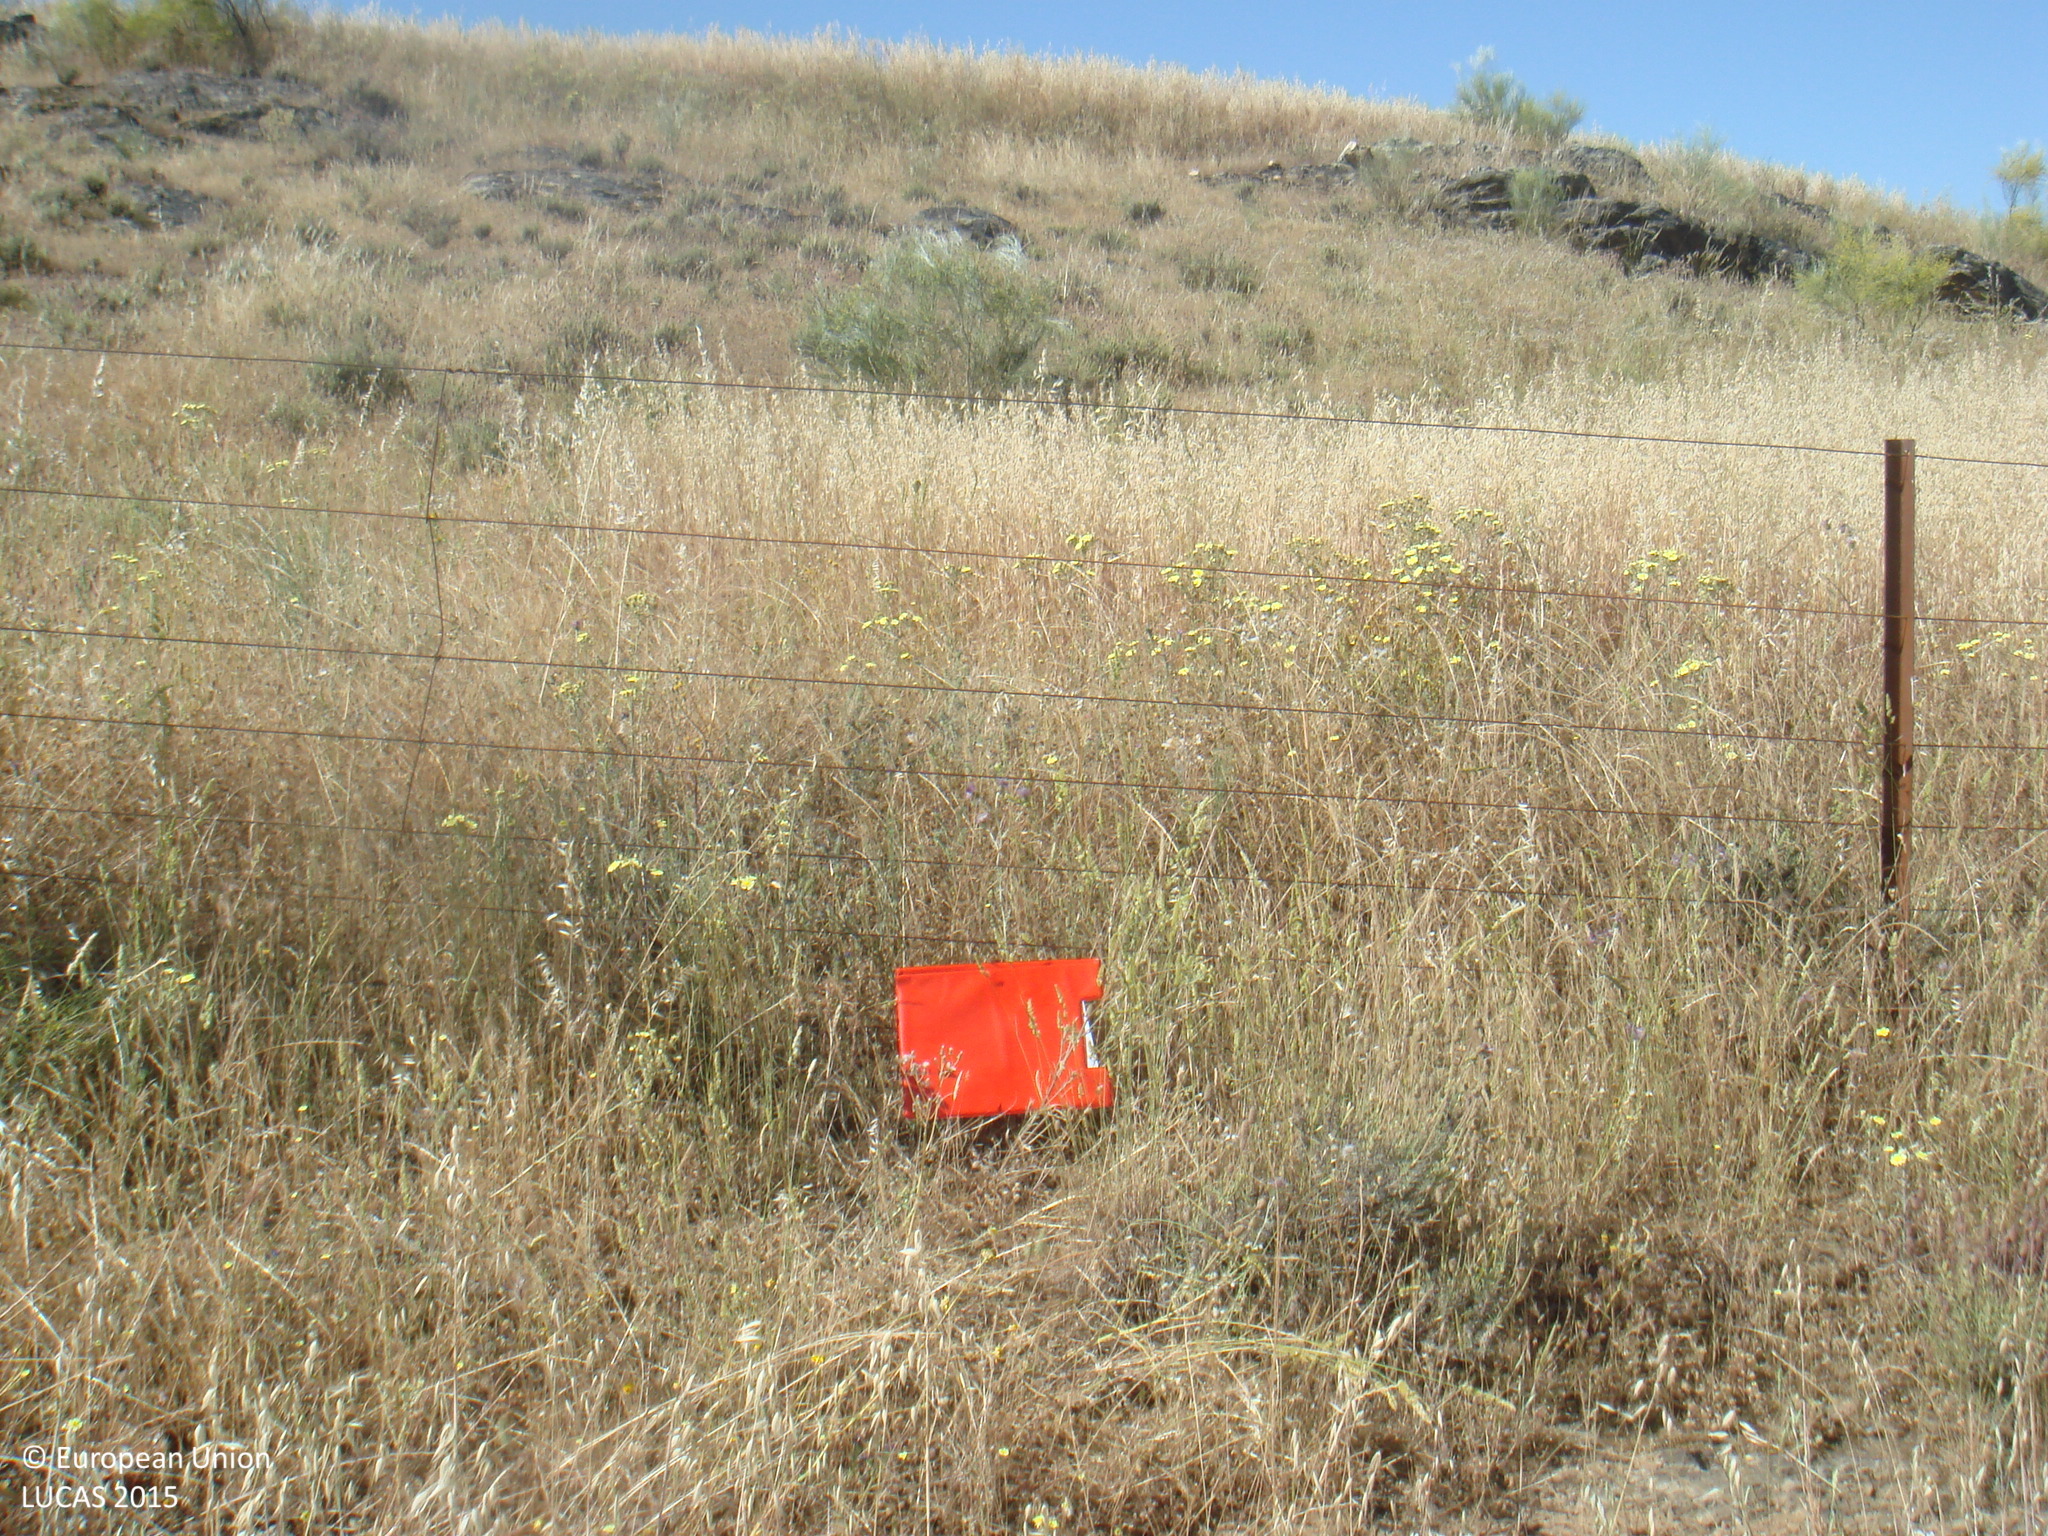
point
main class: Cropland
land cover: Oats
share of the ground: 50 - 75 %
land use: Agriculture (excluding fallow land and kitchen gardens)
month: May
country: ES
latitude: 38.6400
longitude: -5.1630
